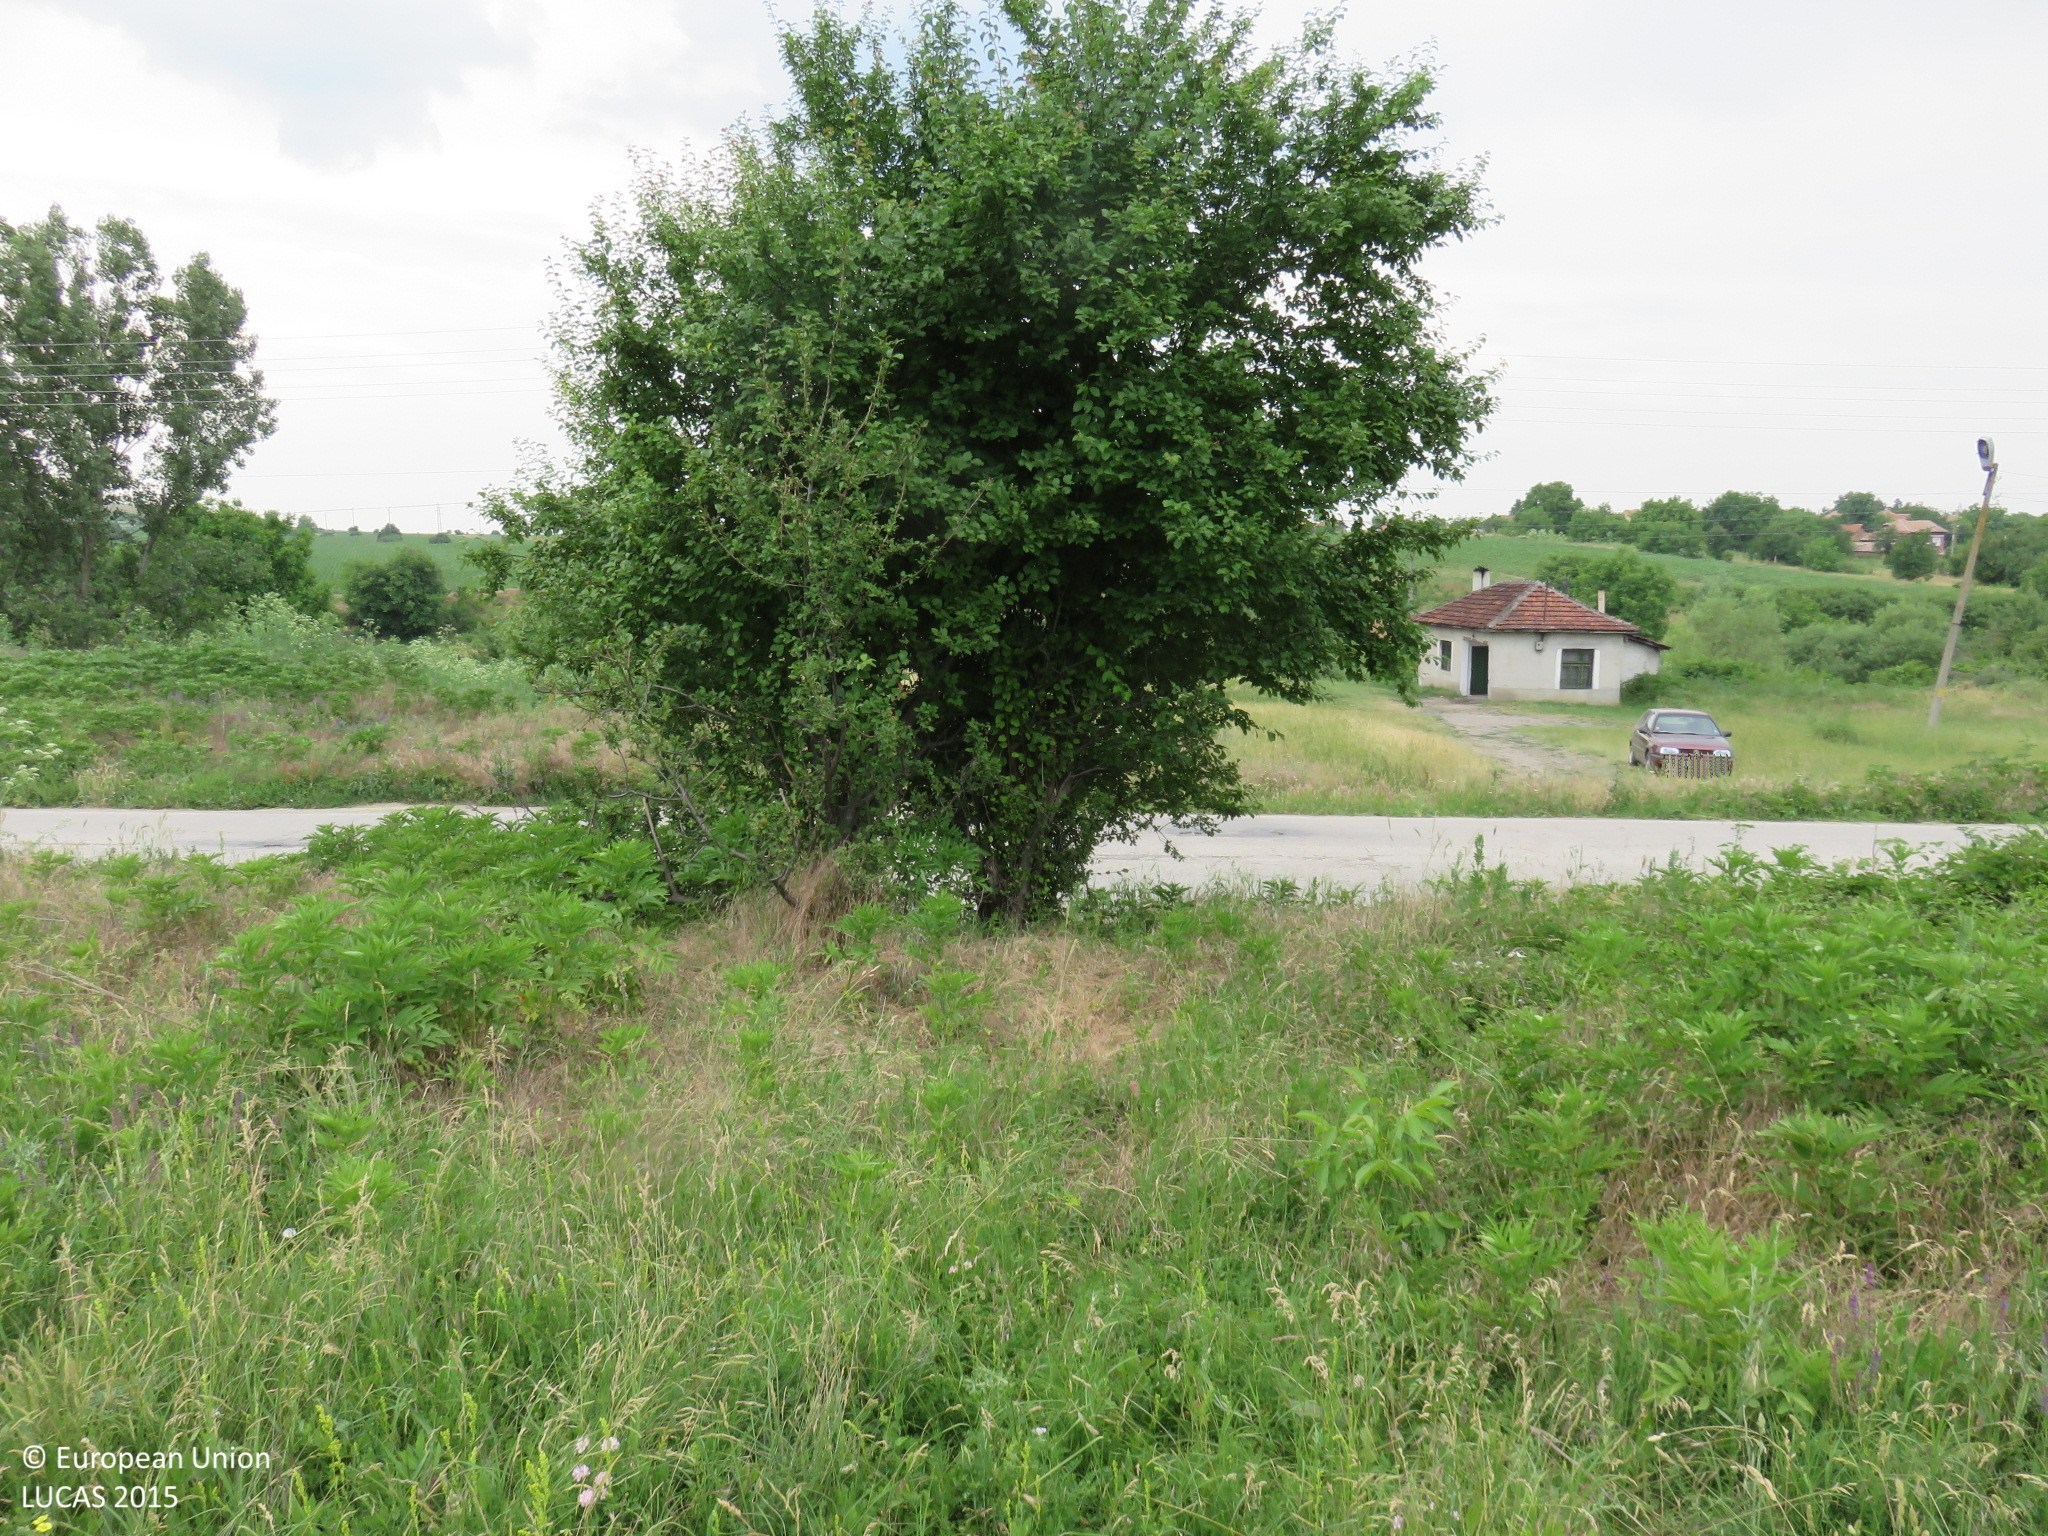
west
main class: Grassland
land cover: Grassland without tree/shrub cover
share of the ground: > 75 %
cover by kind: herbaceous plants 100 %
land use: Semi-natural and natural areas not in use
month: June
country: BG
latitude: 43.3468
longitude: 24.4809
